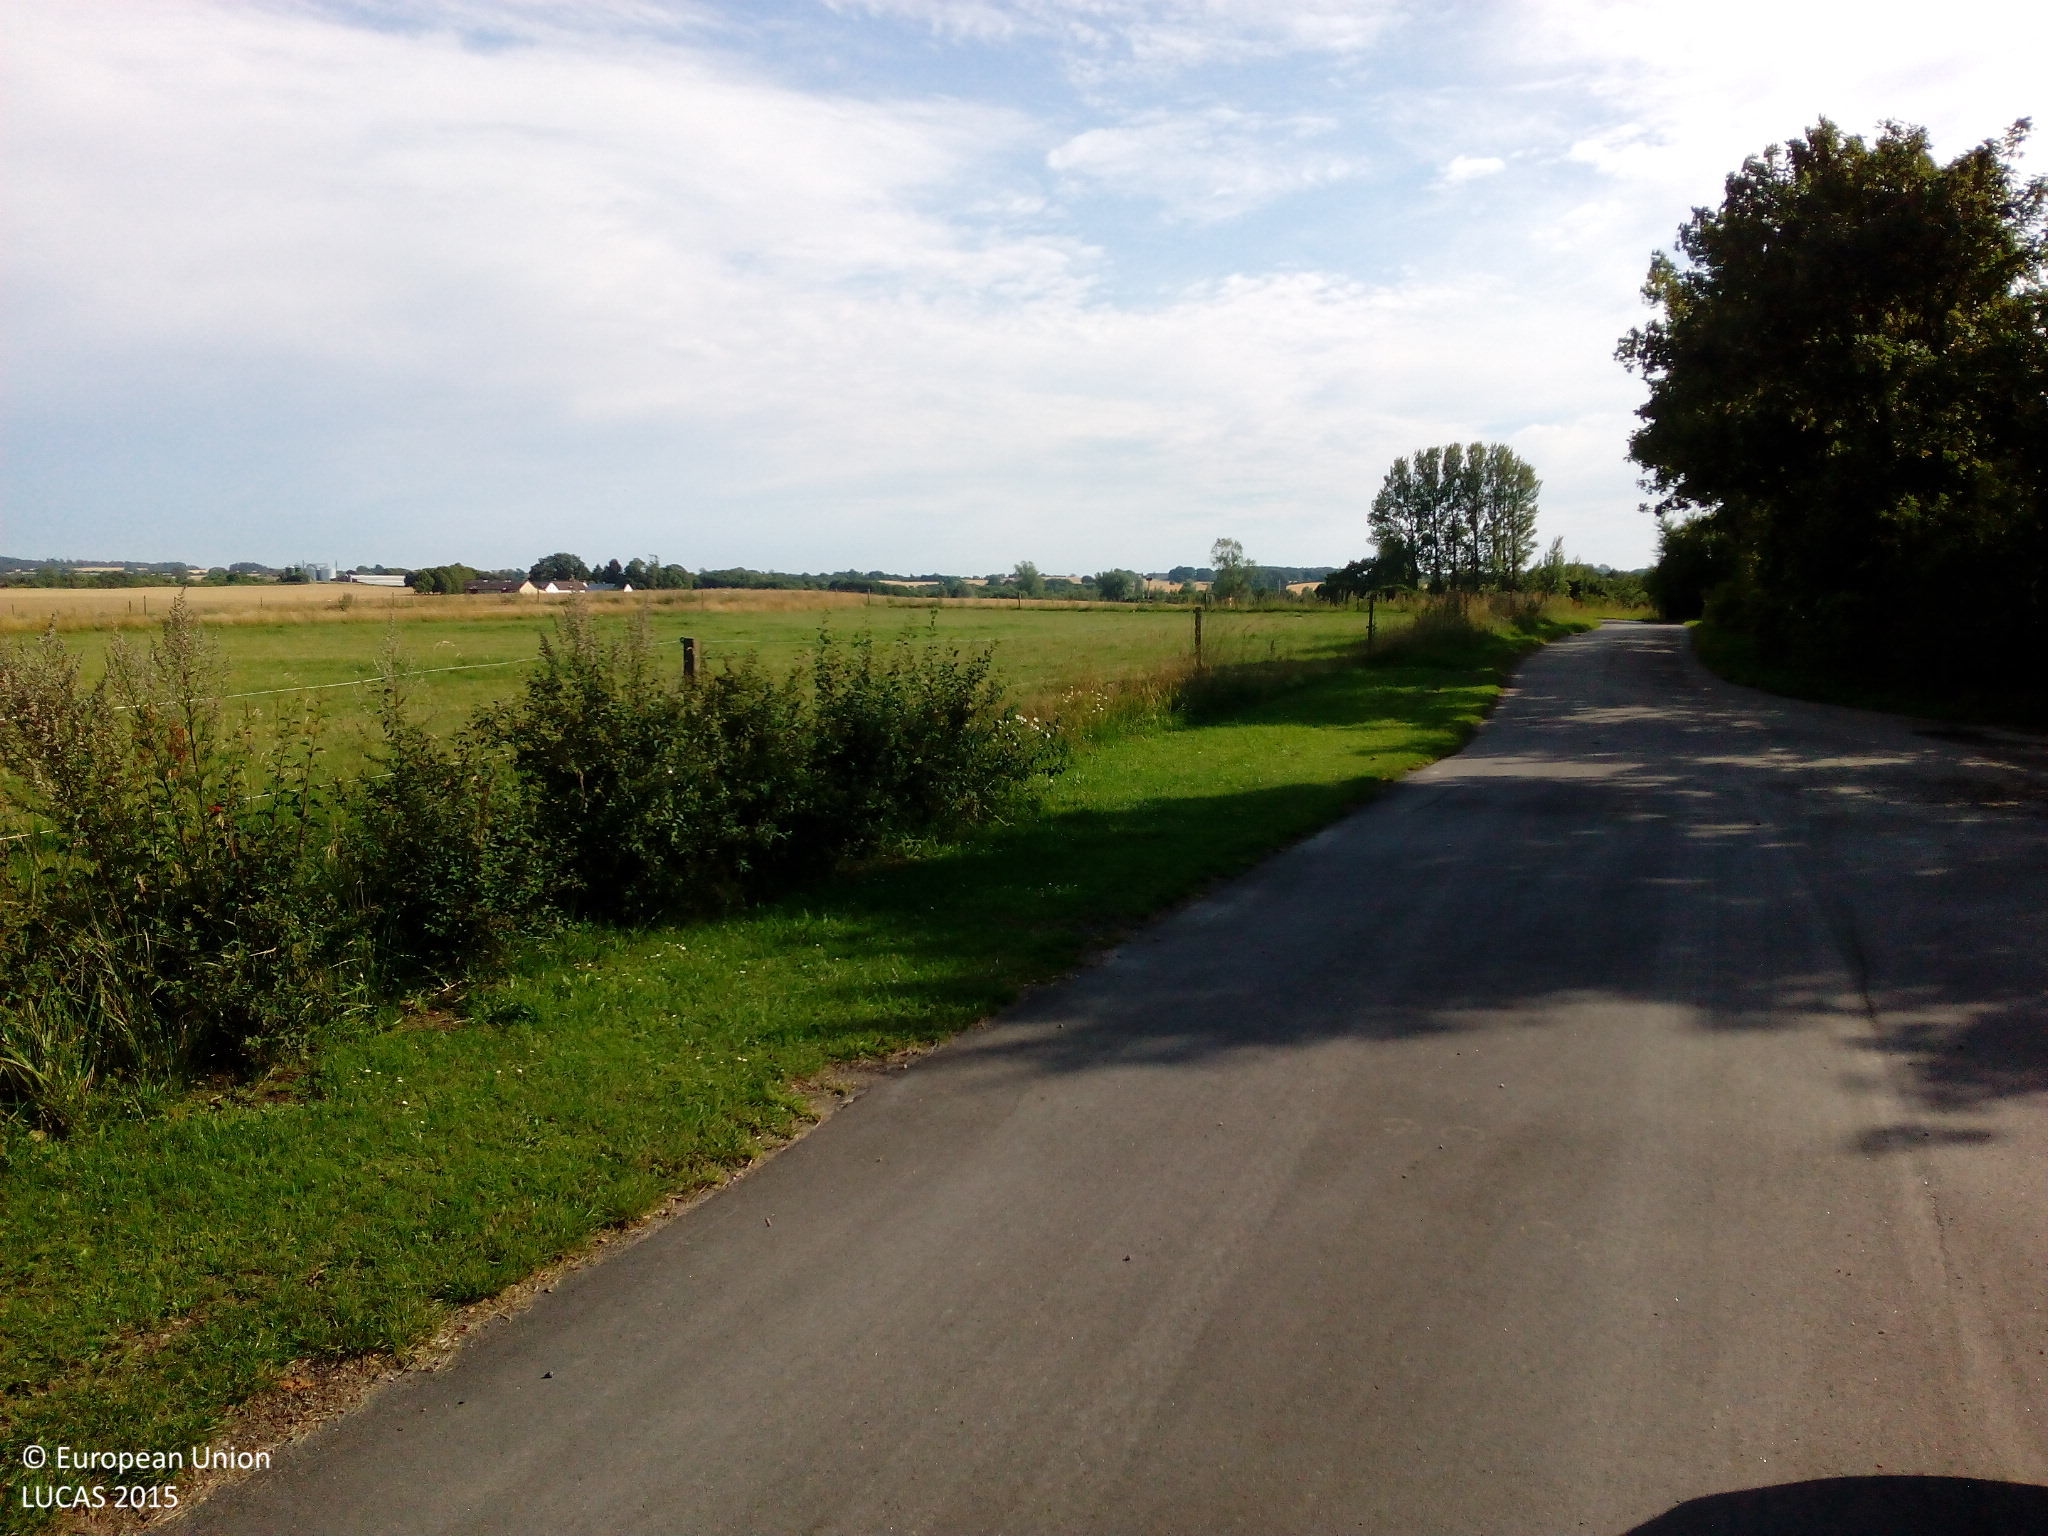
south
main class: Cropland
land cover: Barley
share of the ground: > 75 %
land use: Agriculture (excluding fallow land and kitchen gardens)
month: August
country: DK
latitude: 55.5657
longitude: 11.6635
